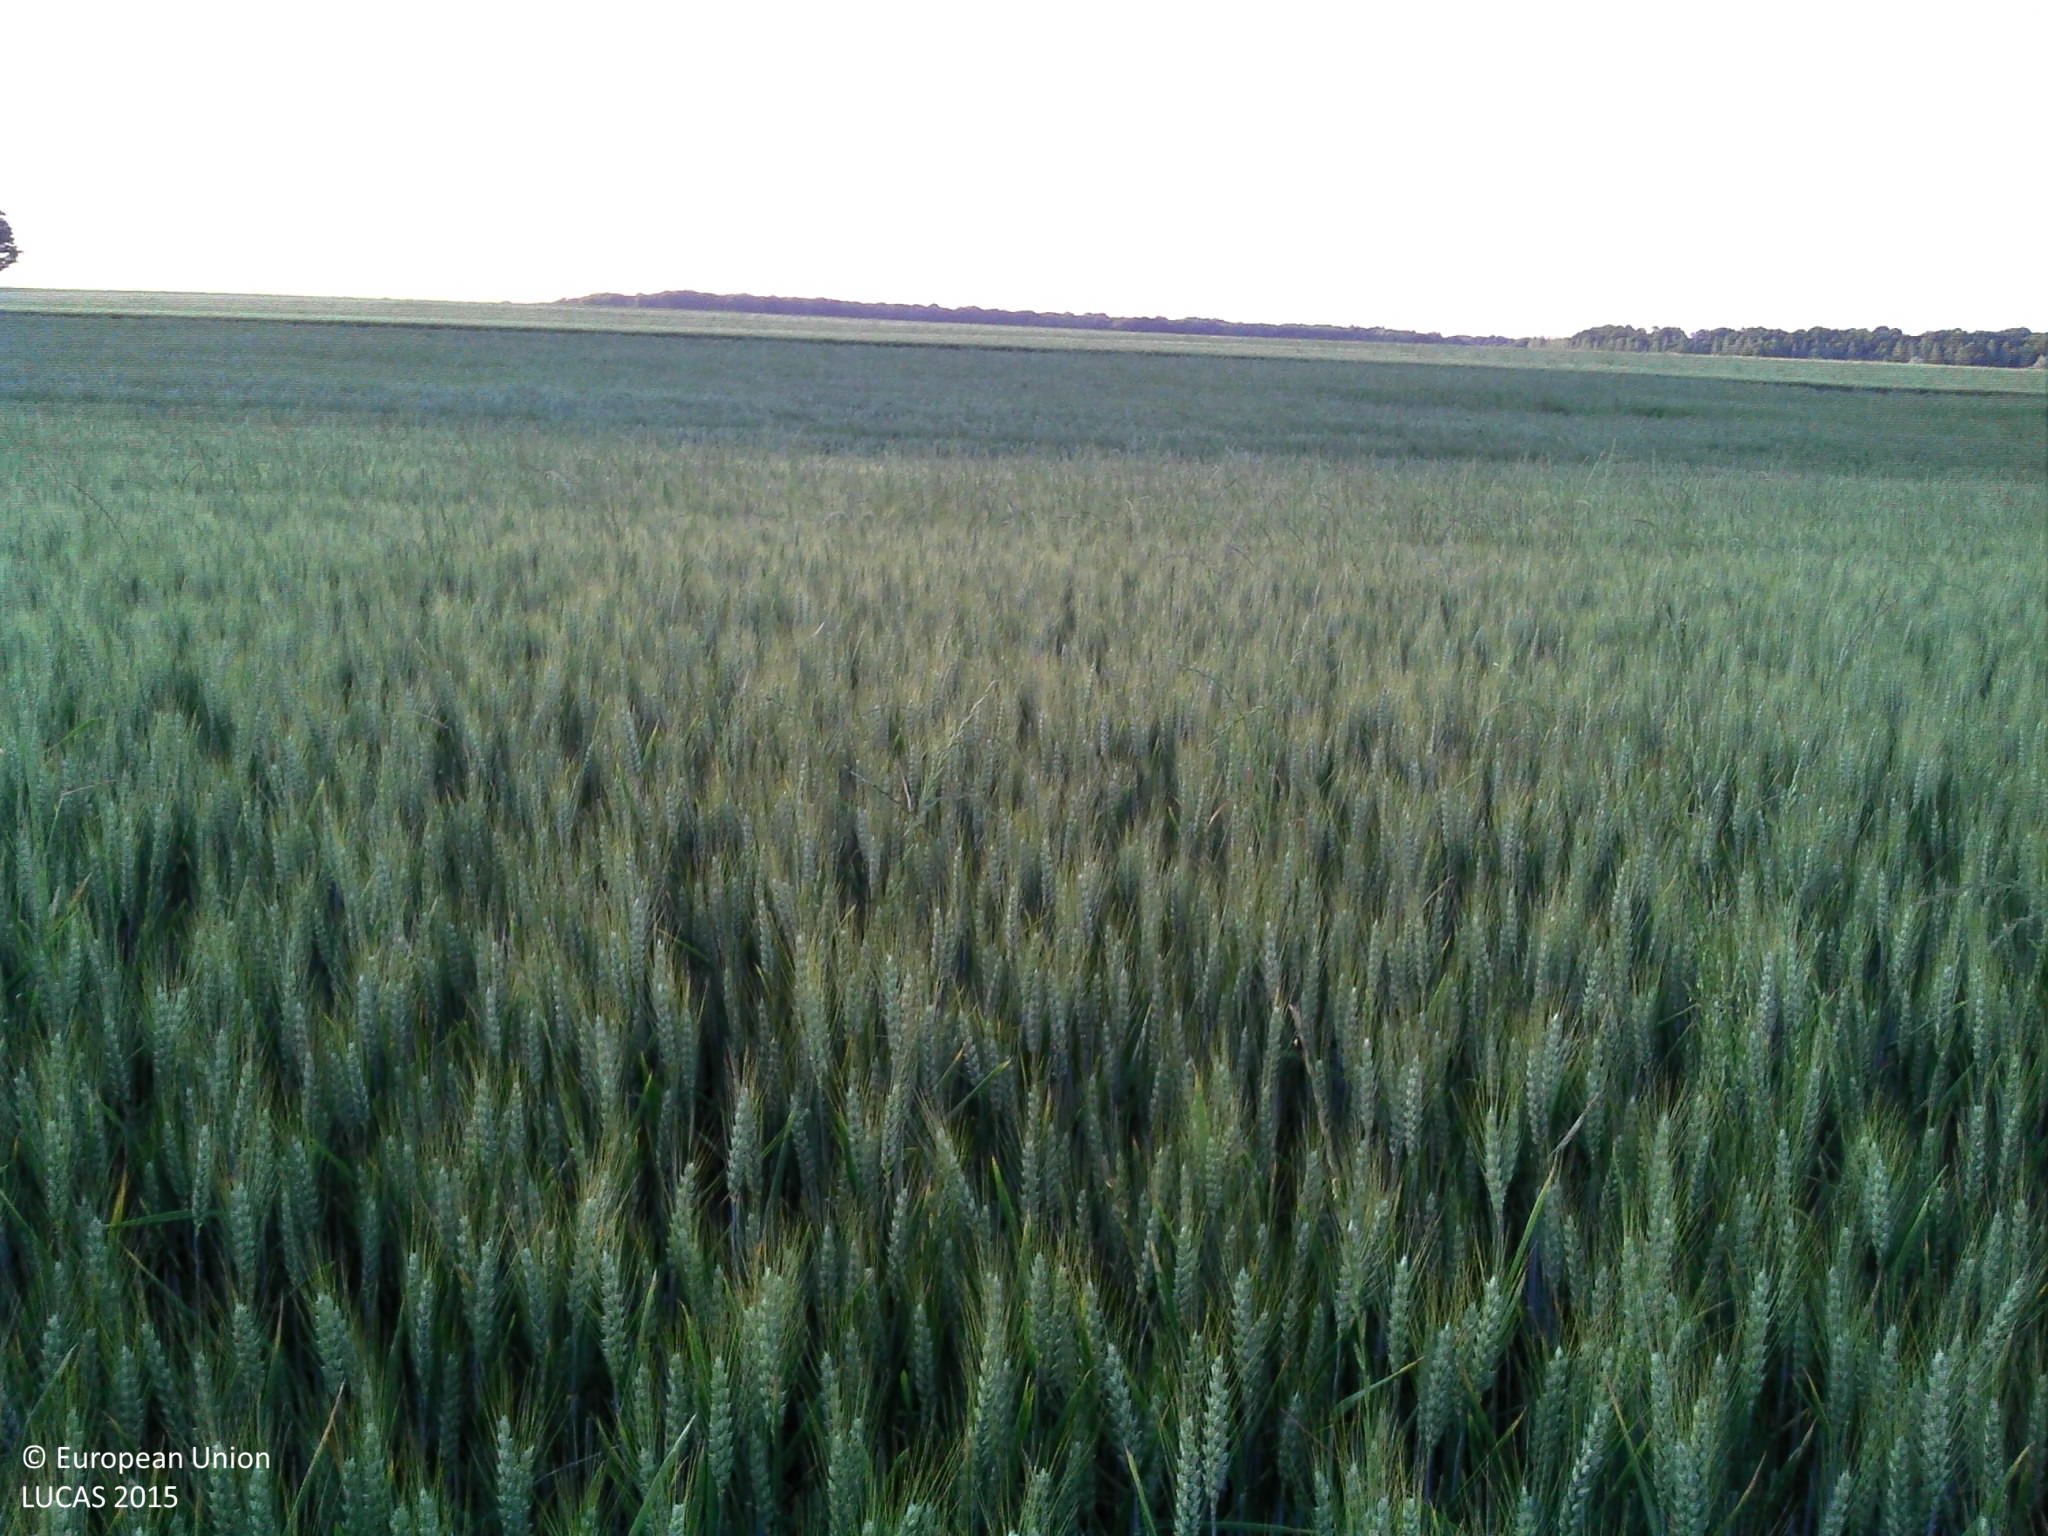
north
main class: Cropland
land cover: Common wheat
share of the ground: > 75 %
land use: Agriculture (excluding fallow land and kitchen gardens)
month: June
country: FR
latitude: 46.8580
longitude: 2.9260
